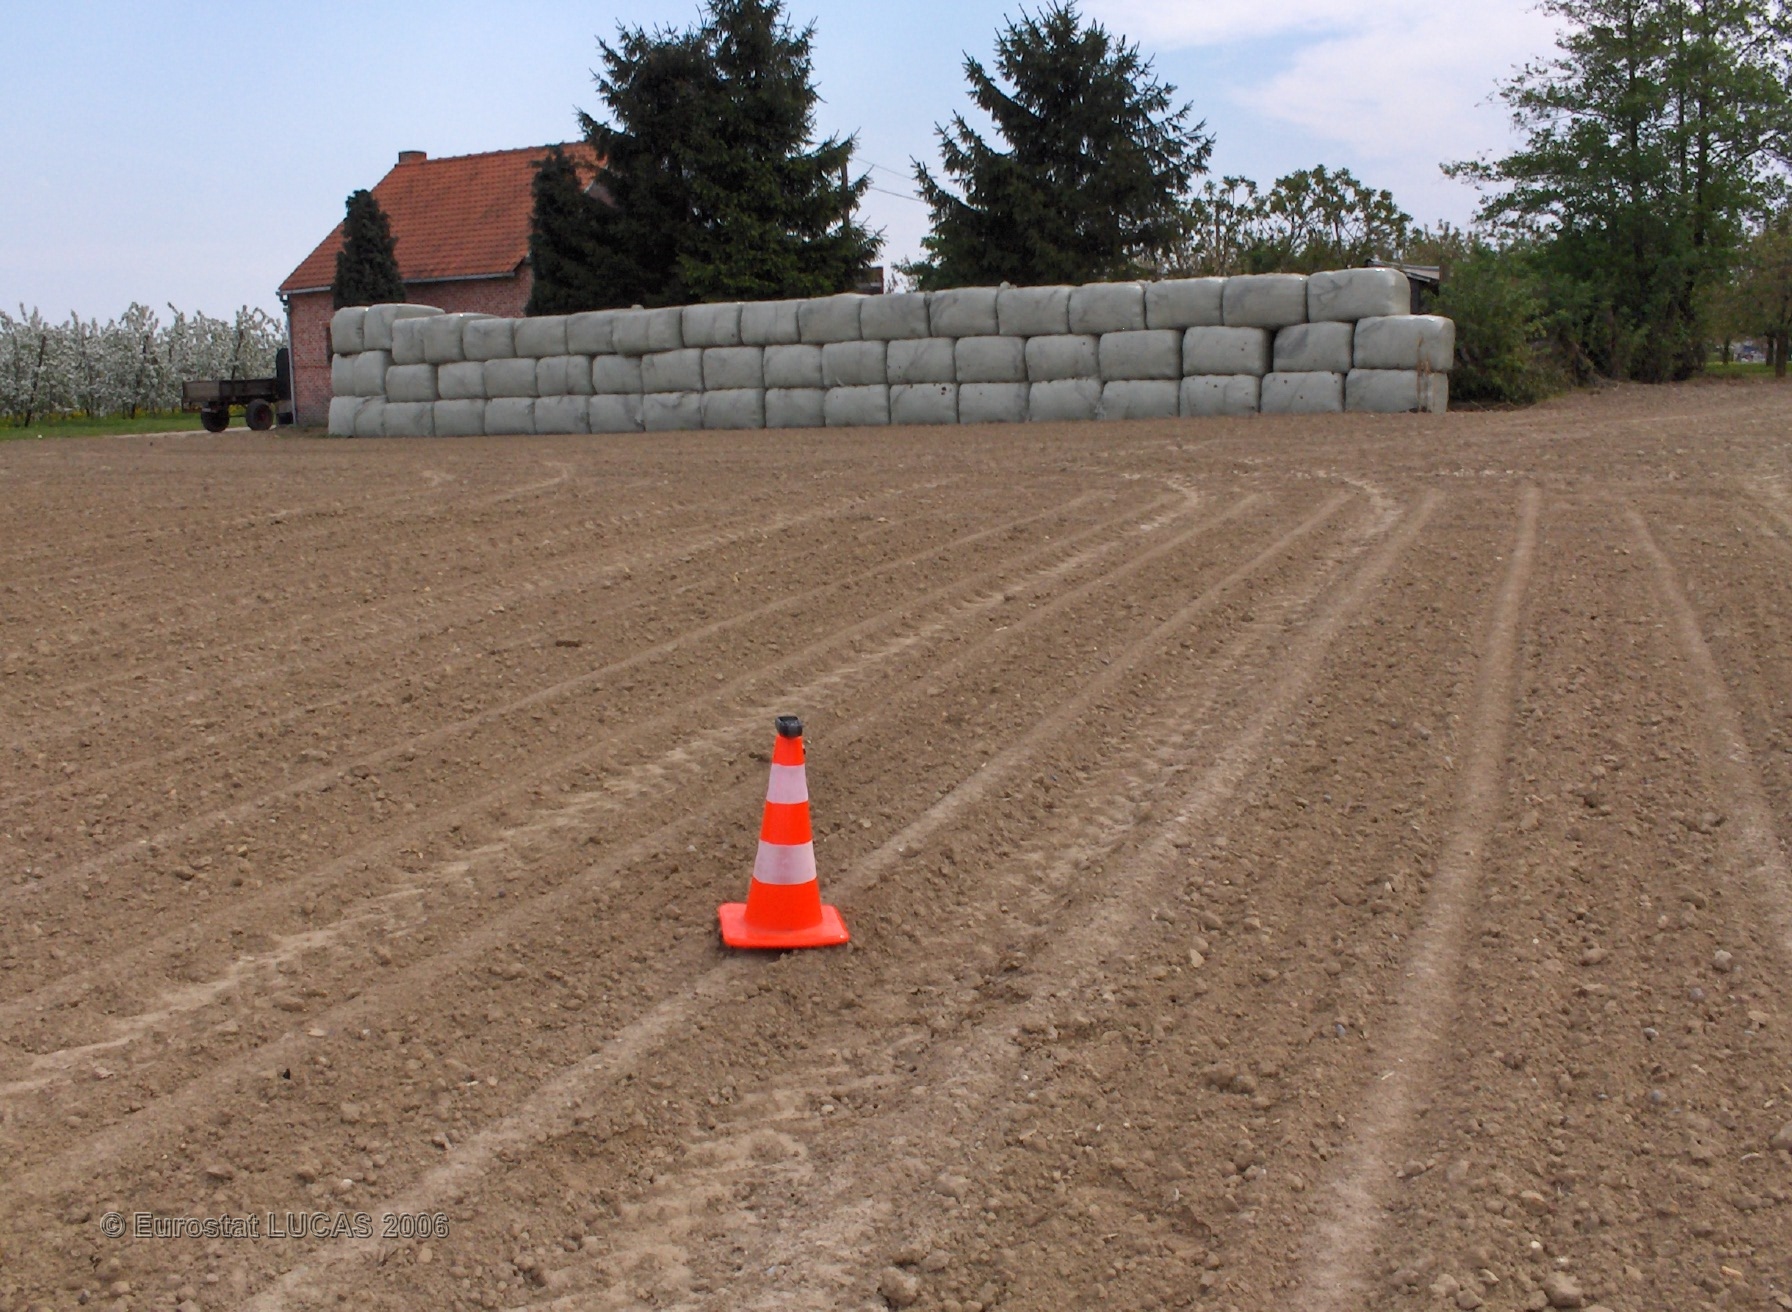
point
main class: Cropland
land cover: Maize
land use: Agriculture (excluding fallow land and kitchen gardens)
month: May
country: BE
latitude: 50.9120
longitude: 5.2045
